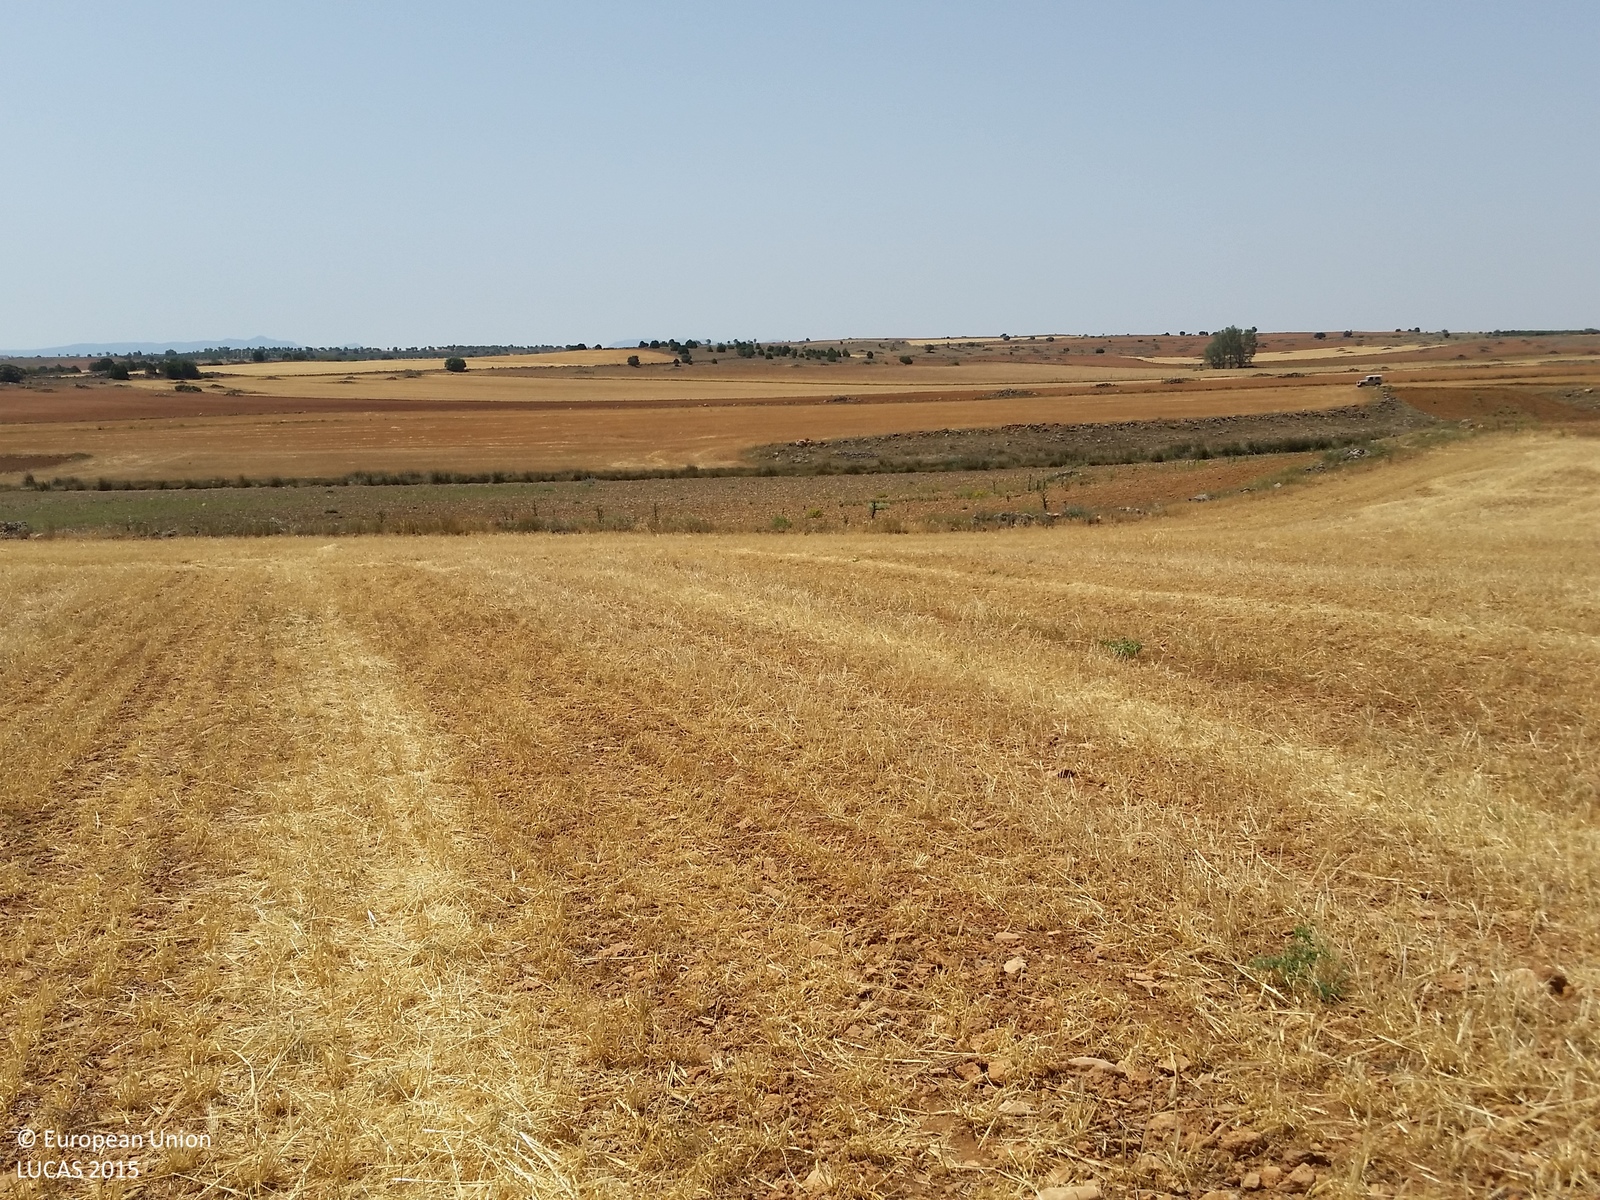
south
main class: Cropland
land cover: Barley
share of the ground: < 10 %
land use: Agriculture (excluding fallow land and kitchen gardens)
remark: Harvested field
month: June
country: ES
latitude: 38.8152
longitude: -2.5686
